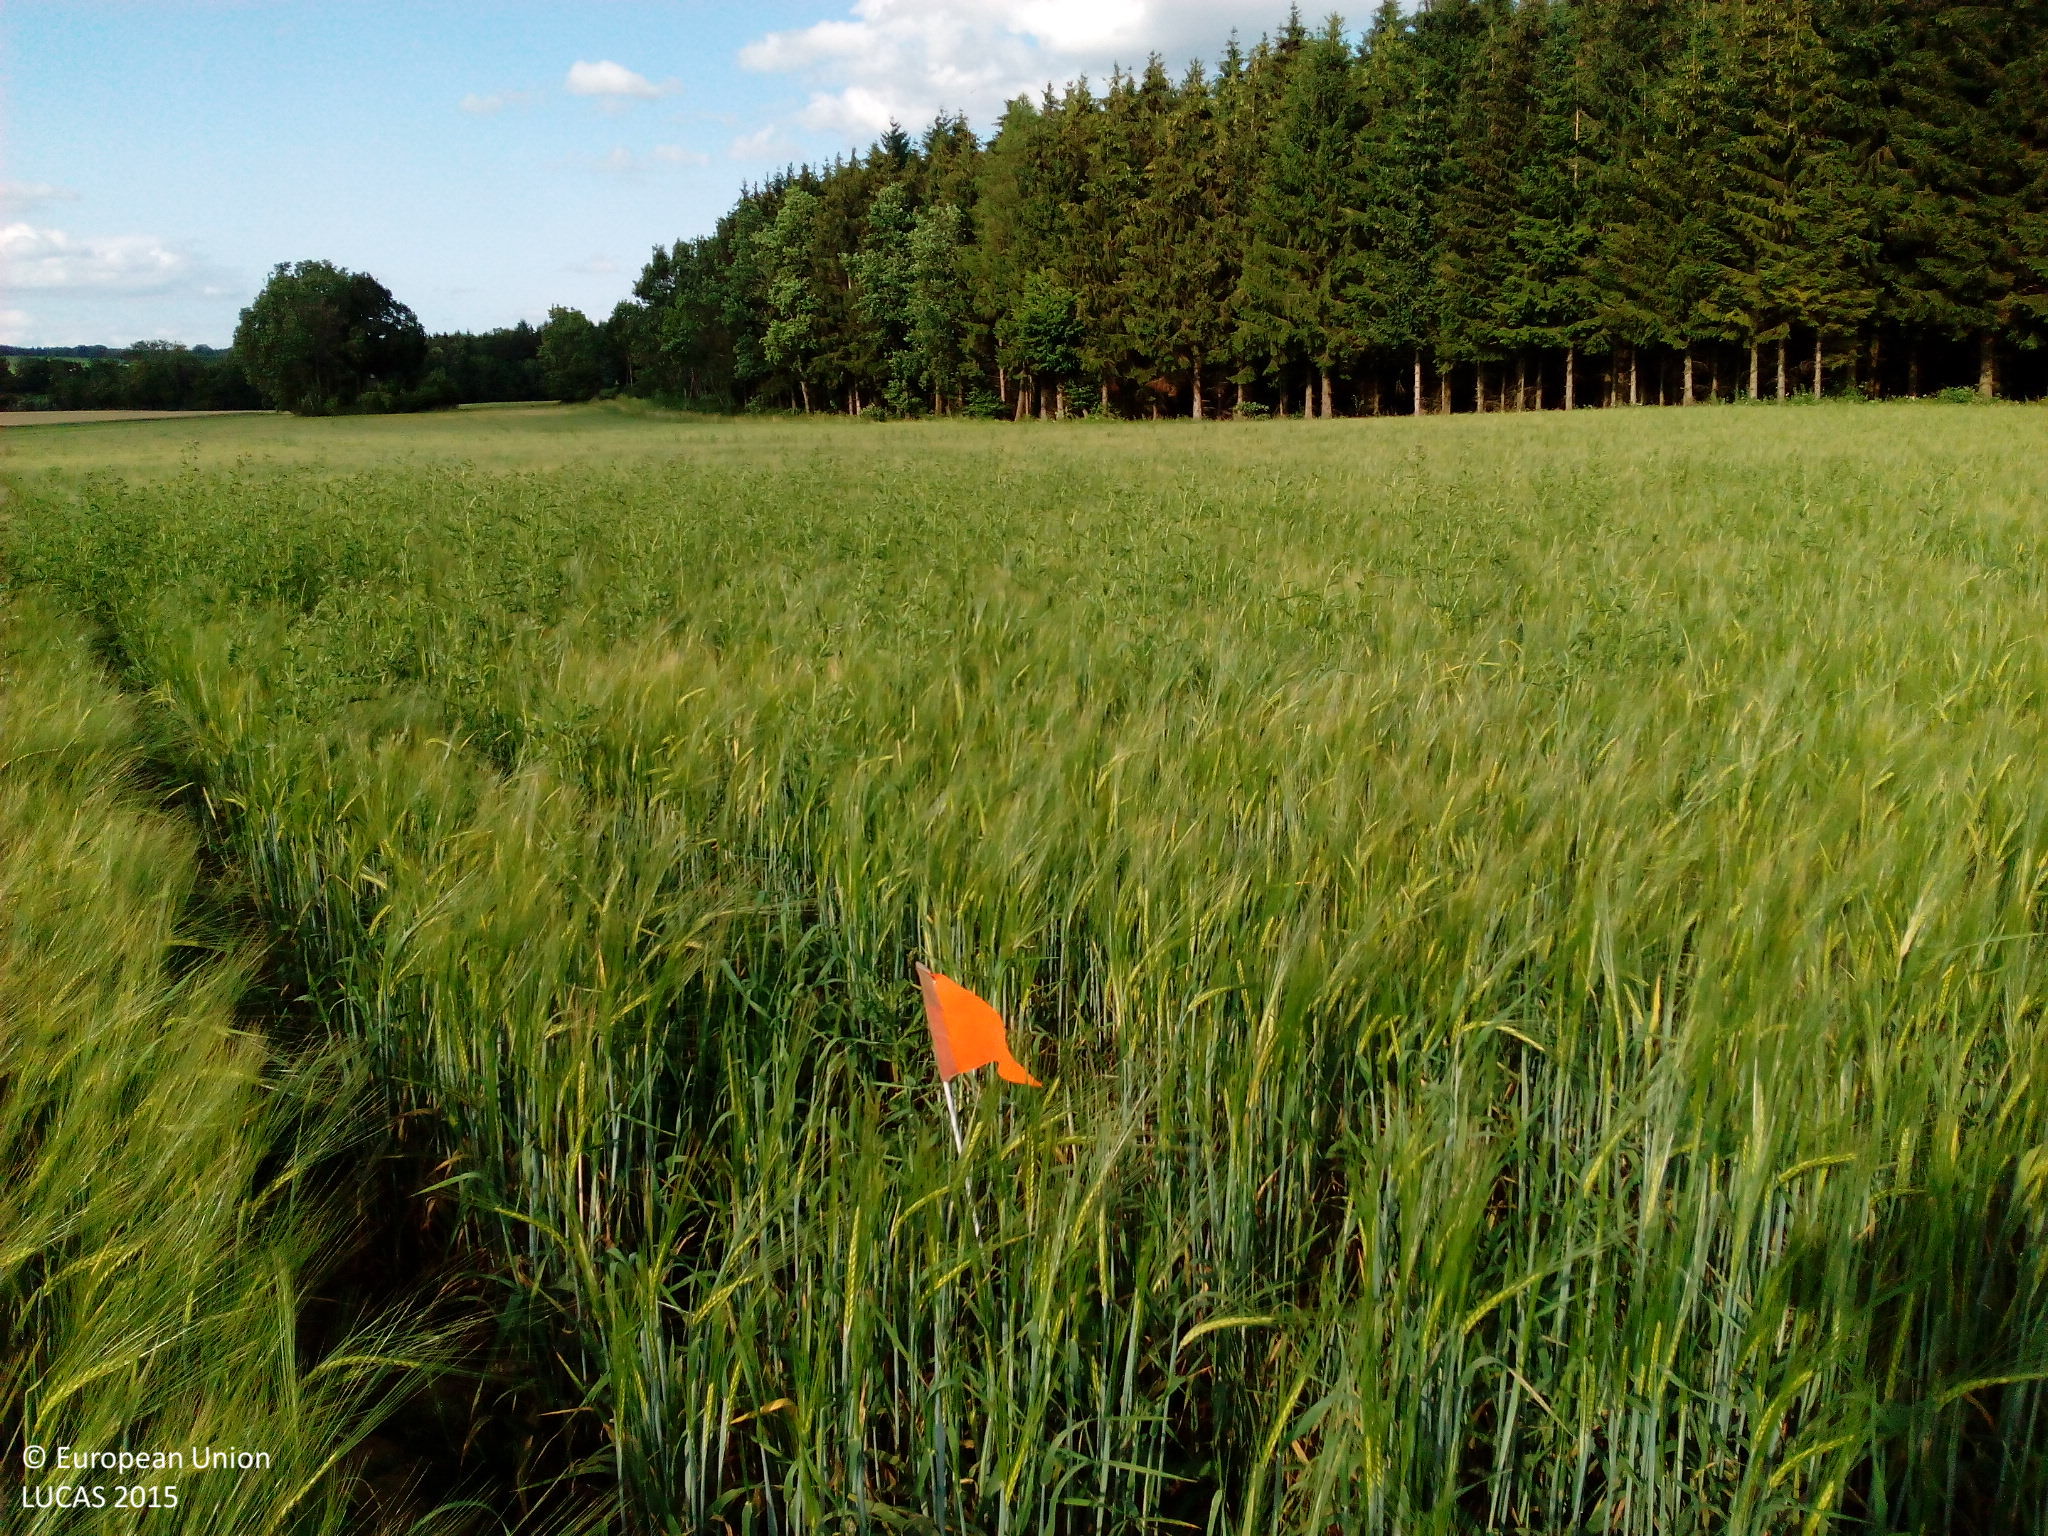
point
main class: Cropland
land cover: Barley
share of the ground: > 75 %
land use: Agriculture (excluding fallow land and kitchen gardens)
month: July
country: DE
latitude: 48.6373
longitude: 9.8508
